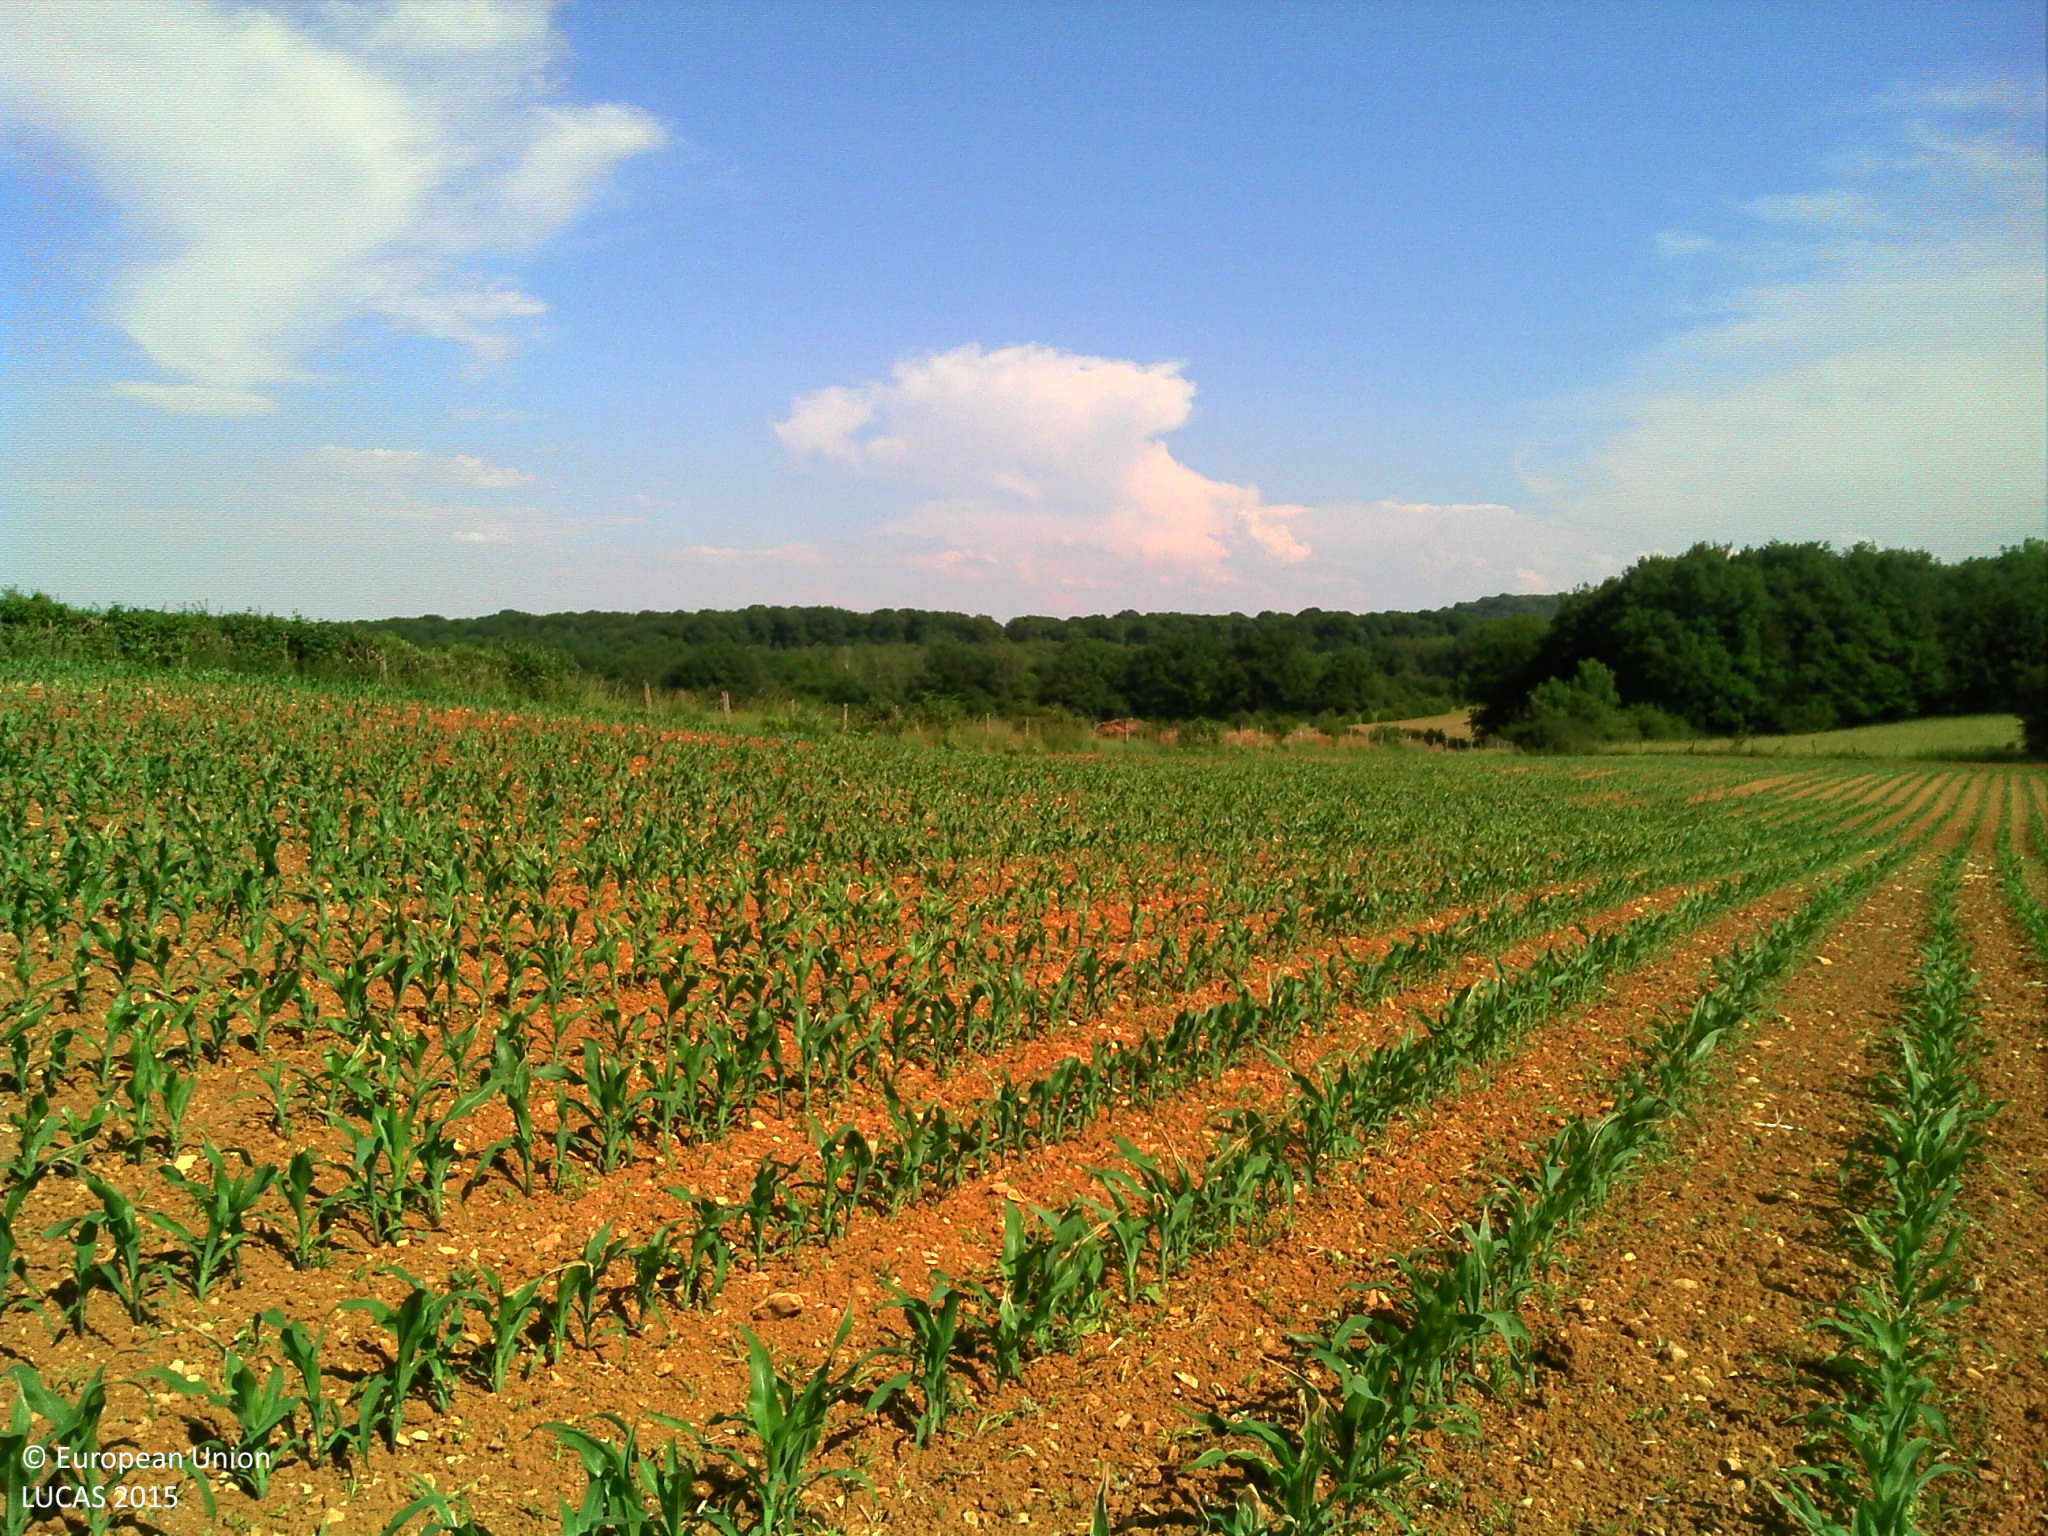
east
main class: Cropland
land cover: Maize
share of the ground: 25 - 50 %
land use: Agriculture (excluding fallow land and kitchen gardens)
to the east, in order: Maize; Fences; Abandoned hedges; Maize; Temporary grasslands
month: June
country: FR
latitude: 47.6386
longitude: 6.2878
